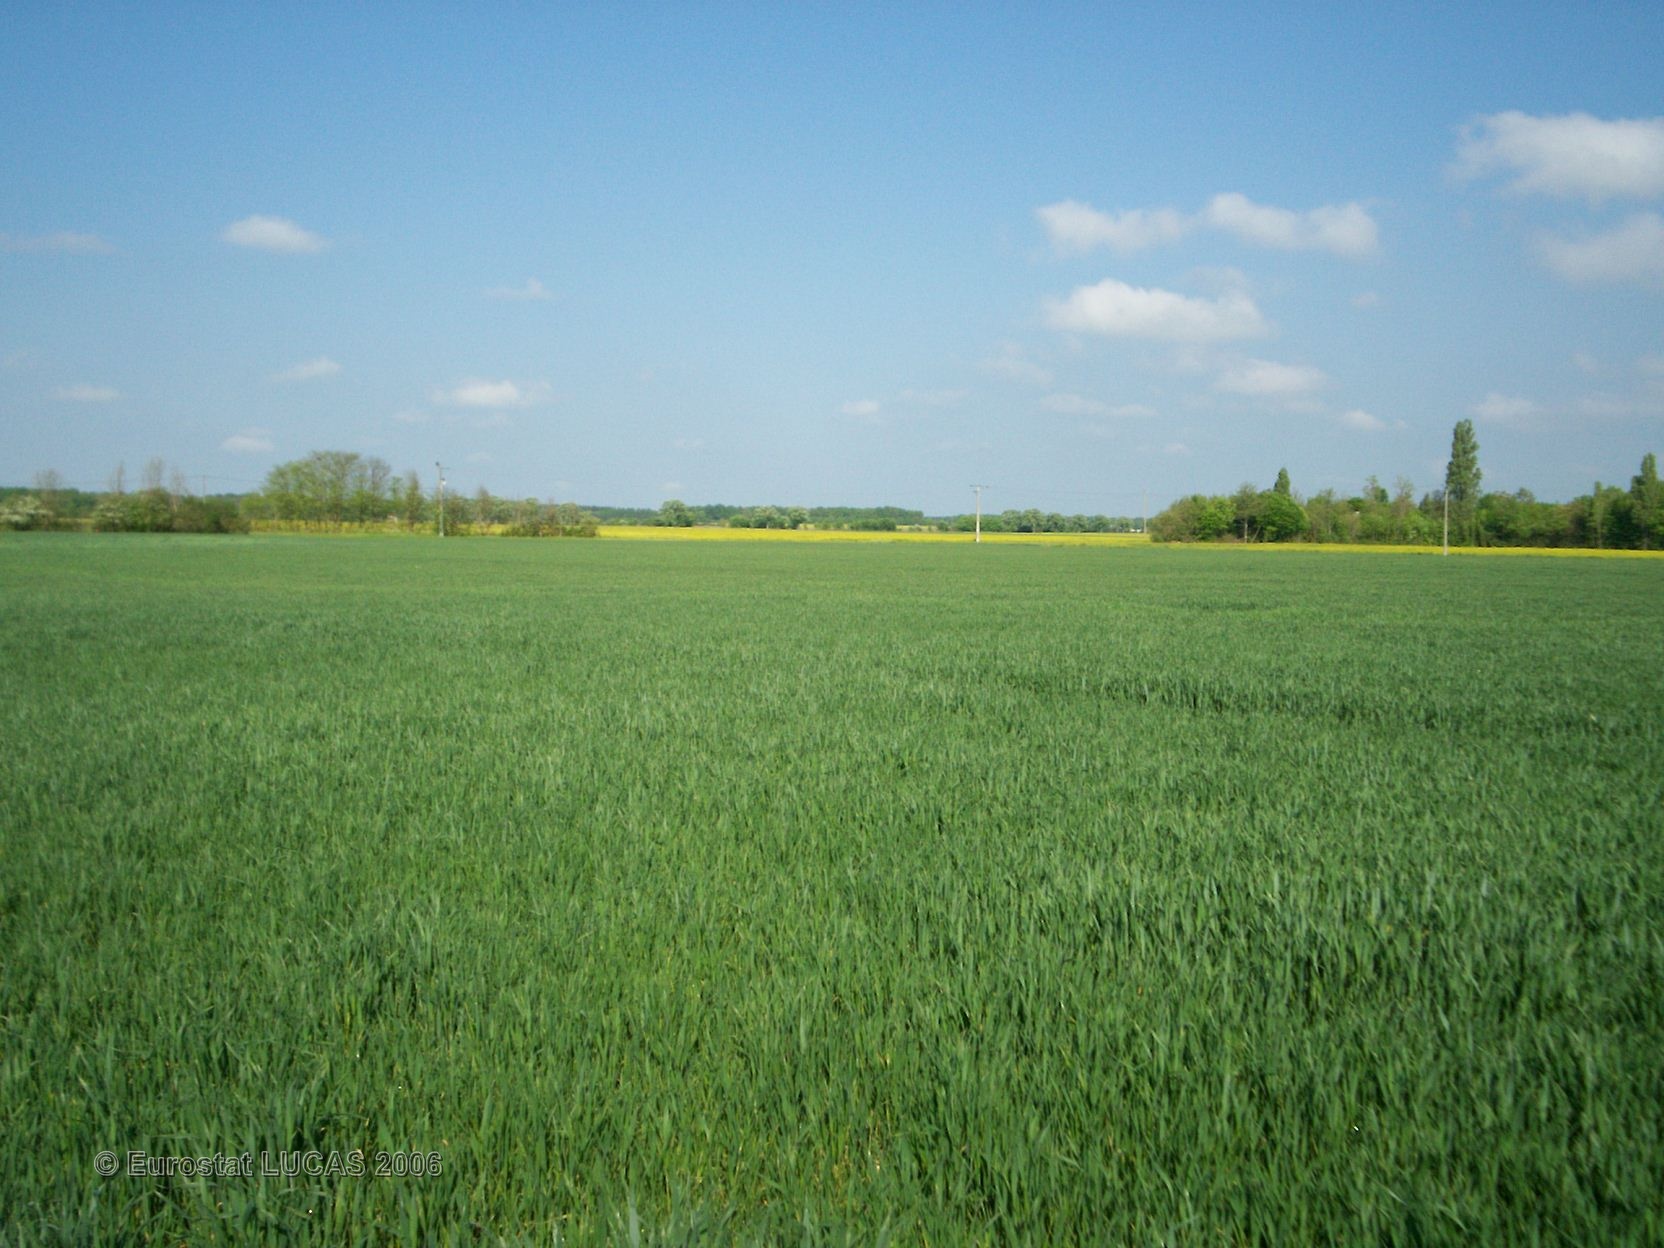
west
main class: Cropland
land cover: Common wheat
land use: Agriculture (excluding fallow land and kitchen gardens)
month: May
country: FR
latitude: 47.4109
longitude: 0.2625
